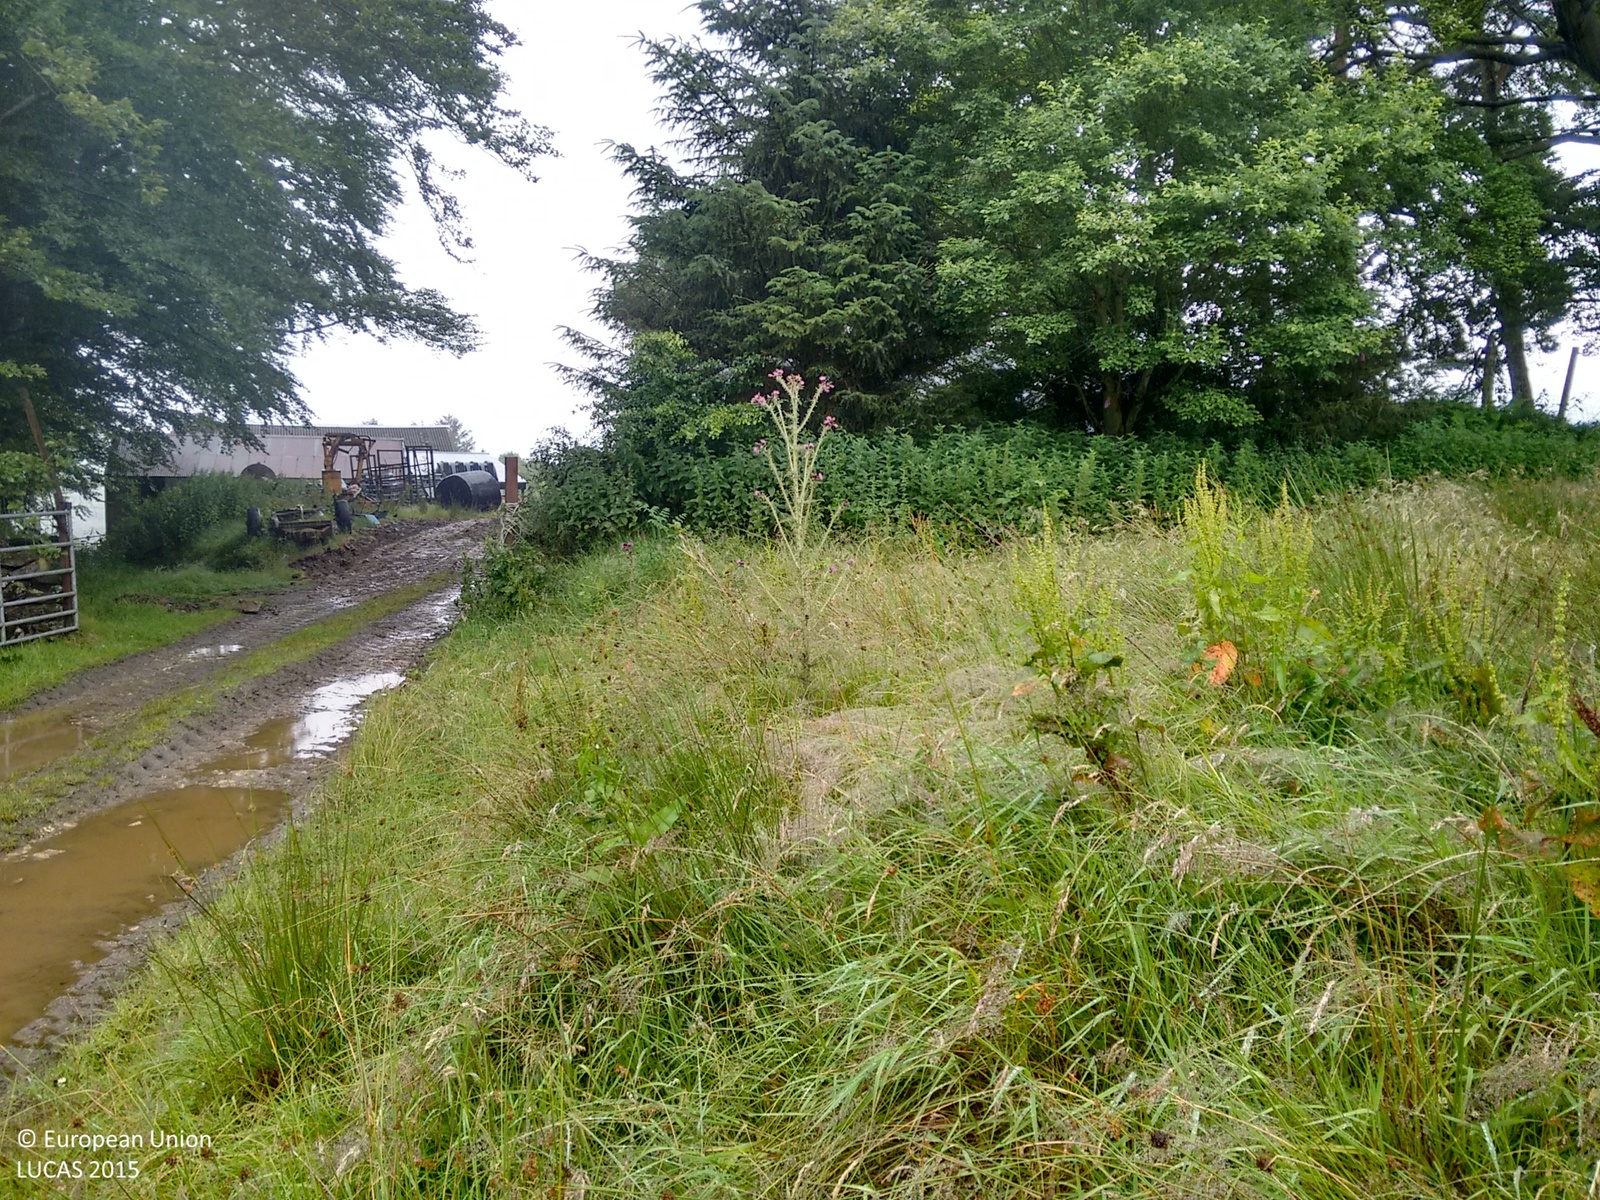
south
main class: Grassland
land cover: Grassland without tree/shrub cover
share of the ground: > 75 %
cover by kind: herbaceous plants 100 %
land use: Agriculture (excluding fallow land and kitchen gardens)
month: July
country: IE
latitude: 52.9050
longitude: -6.3438
